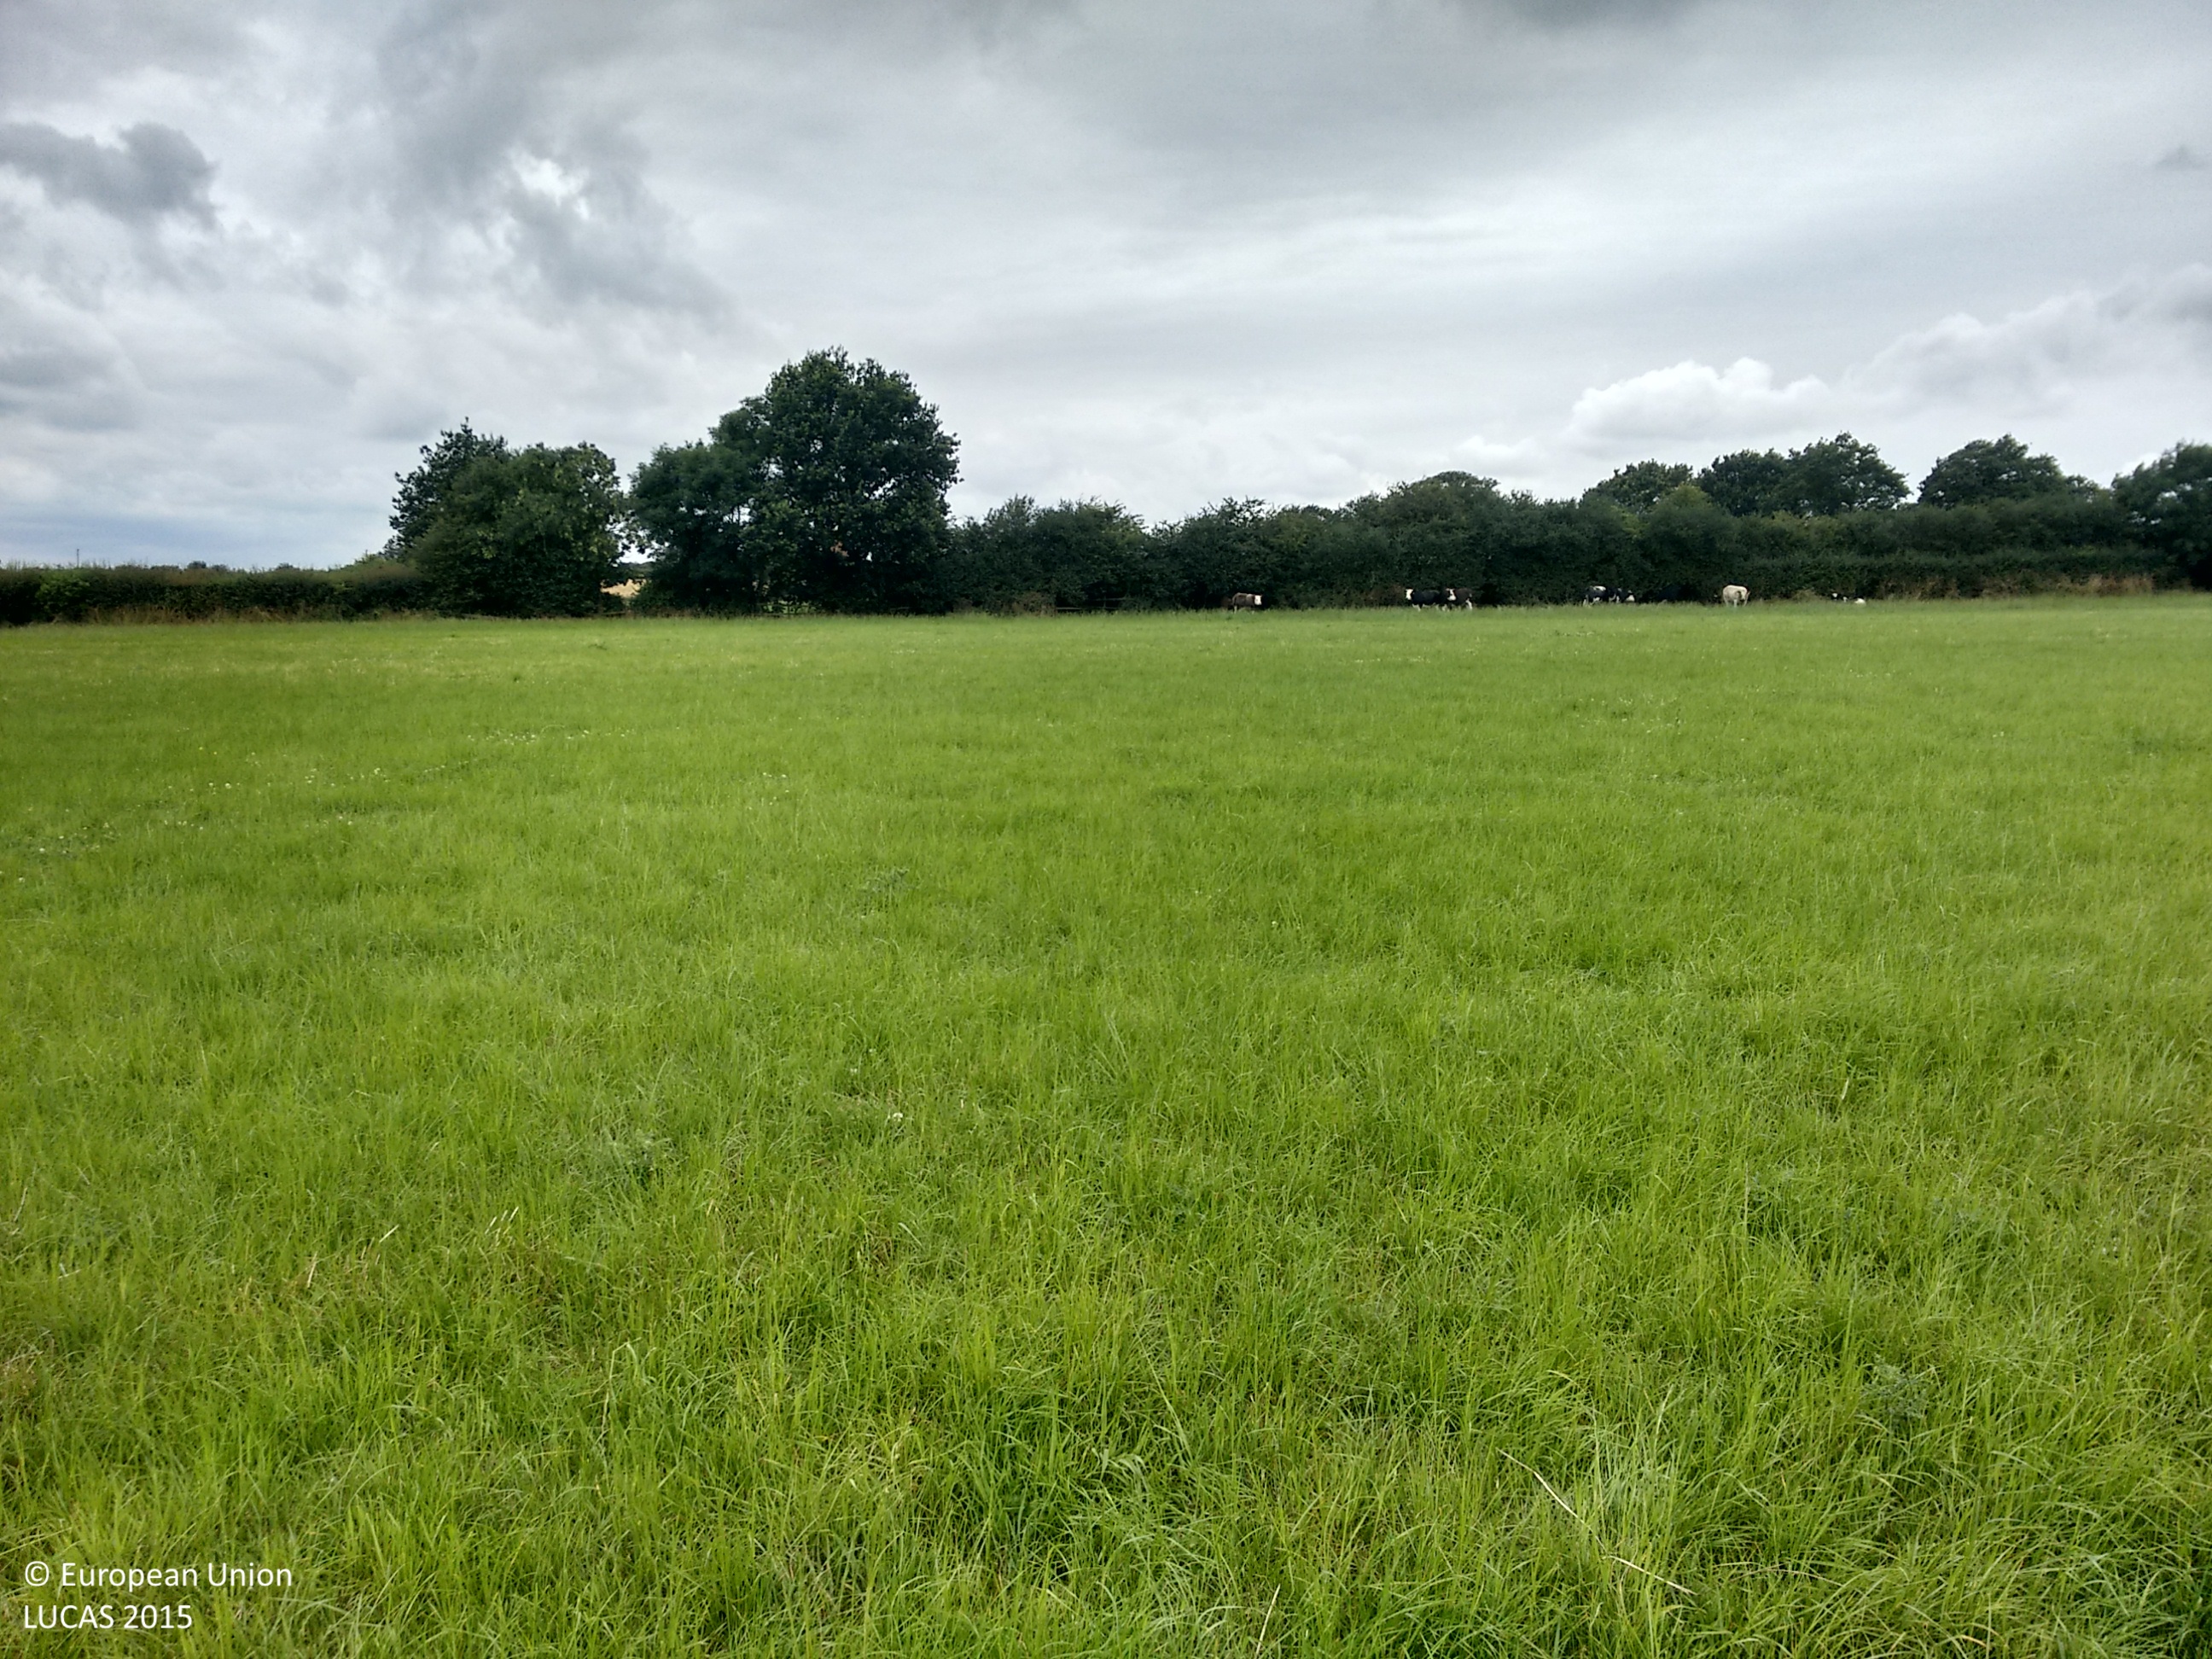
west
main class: Grassland
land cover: Grassland without tree/shrub cover
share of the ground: > 75 %
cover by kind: herbaceous plants 100 %
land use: Agriculture (excluding fallow land and kitchen gardens)
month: July
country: GB
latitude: 52.9071
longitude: -1.3035
